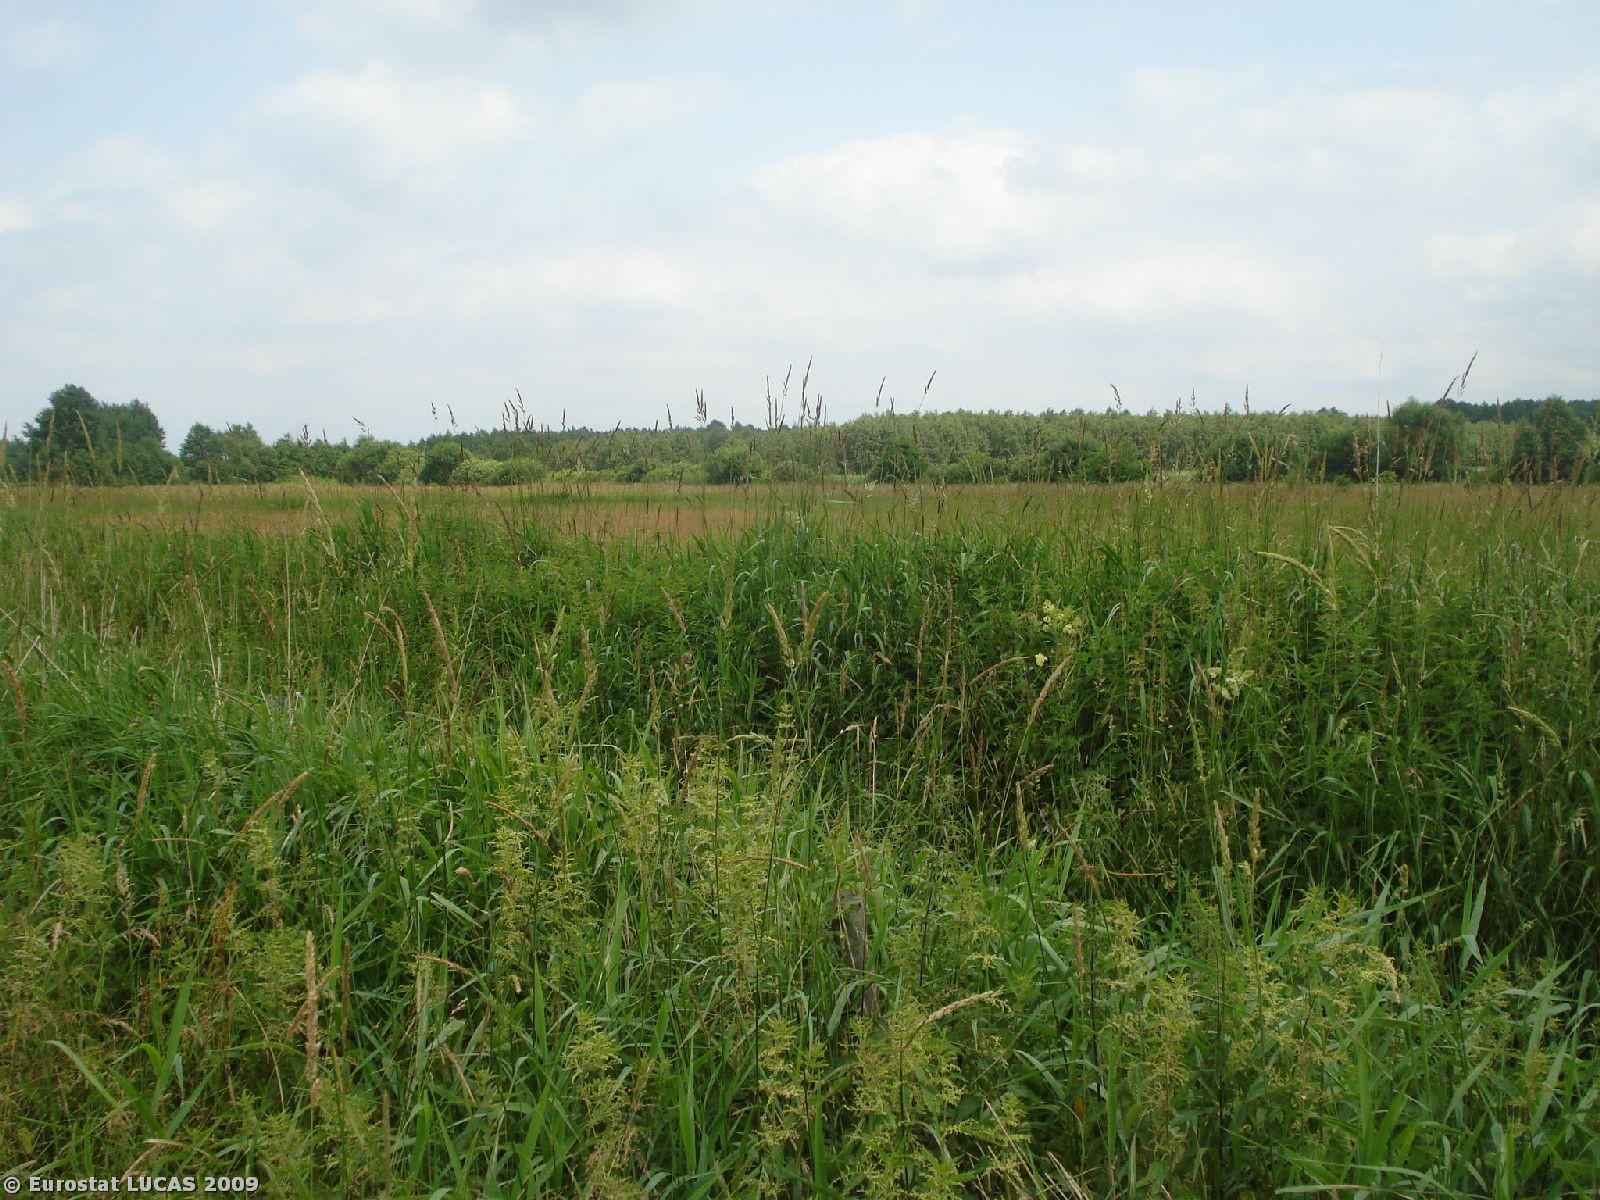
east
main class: Grassland
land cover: Grassland with sparse tree/shrub cover
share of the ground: > 75 %
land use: Agriculture (excluding fallow land and kitchen gardens)
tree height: > 5 m
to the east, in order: Grassland with sparse tree/shrub cover; Tracks; Grassland with sparse tree/shrub cover
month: July
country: PL
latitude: 52.6226
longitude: 23.1810
